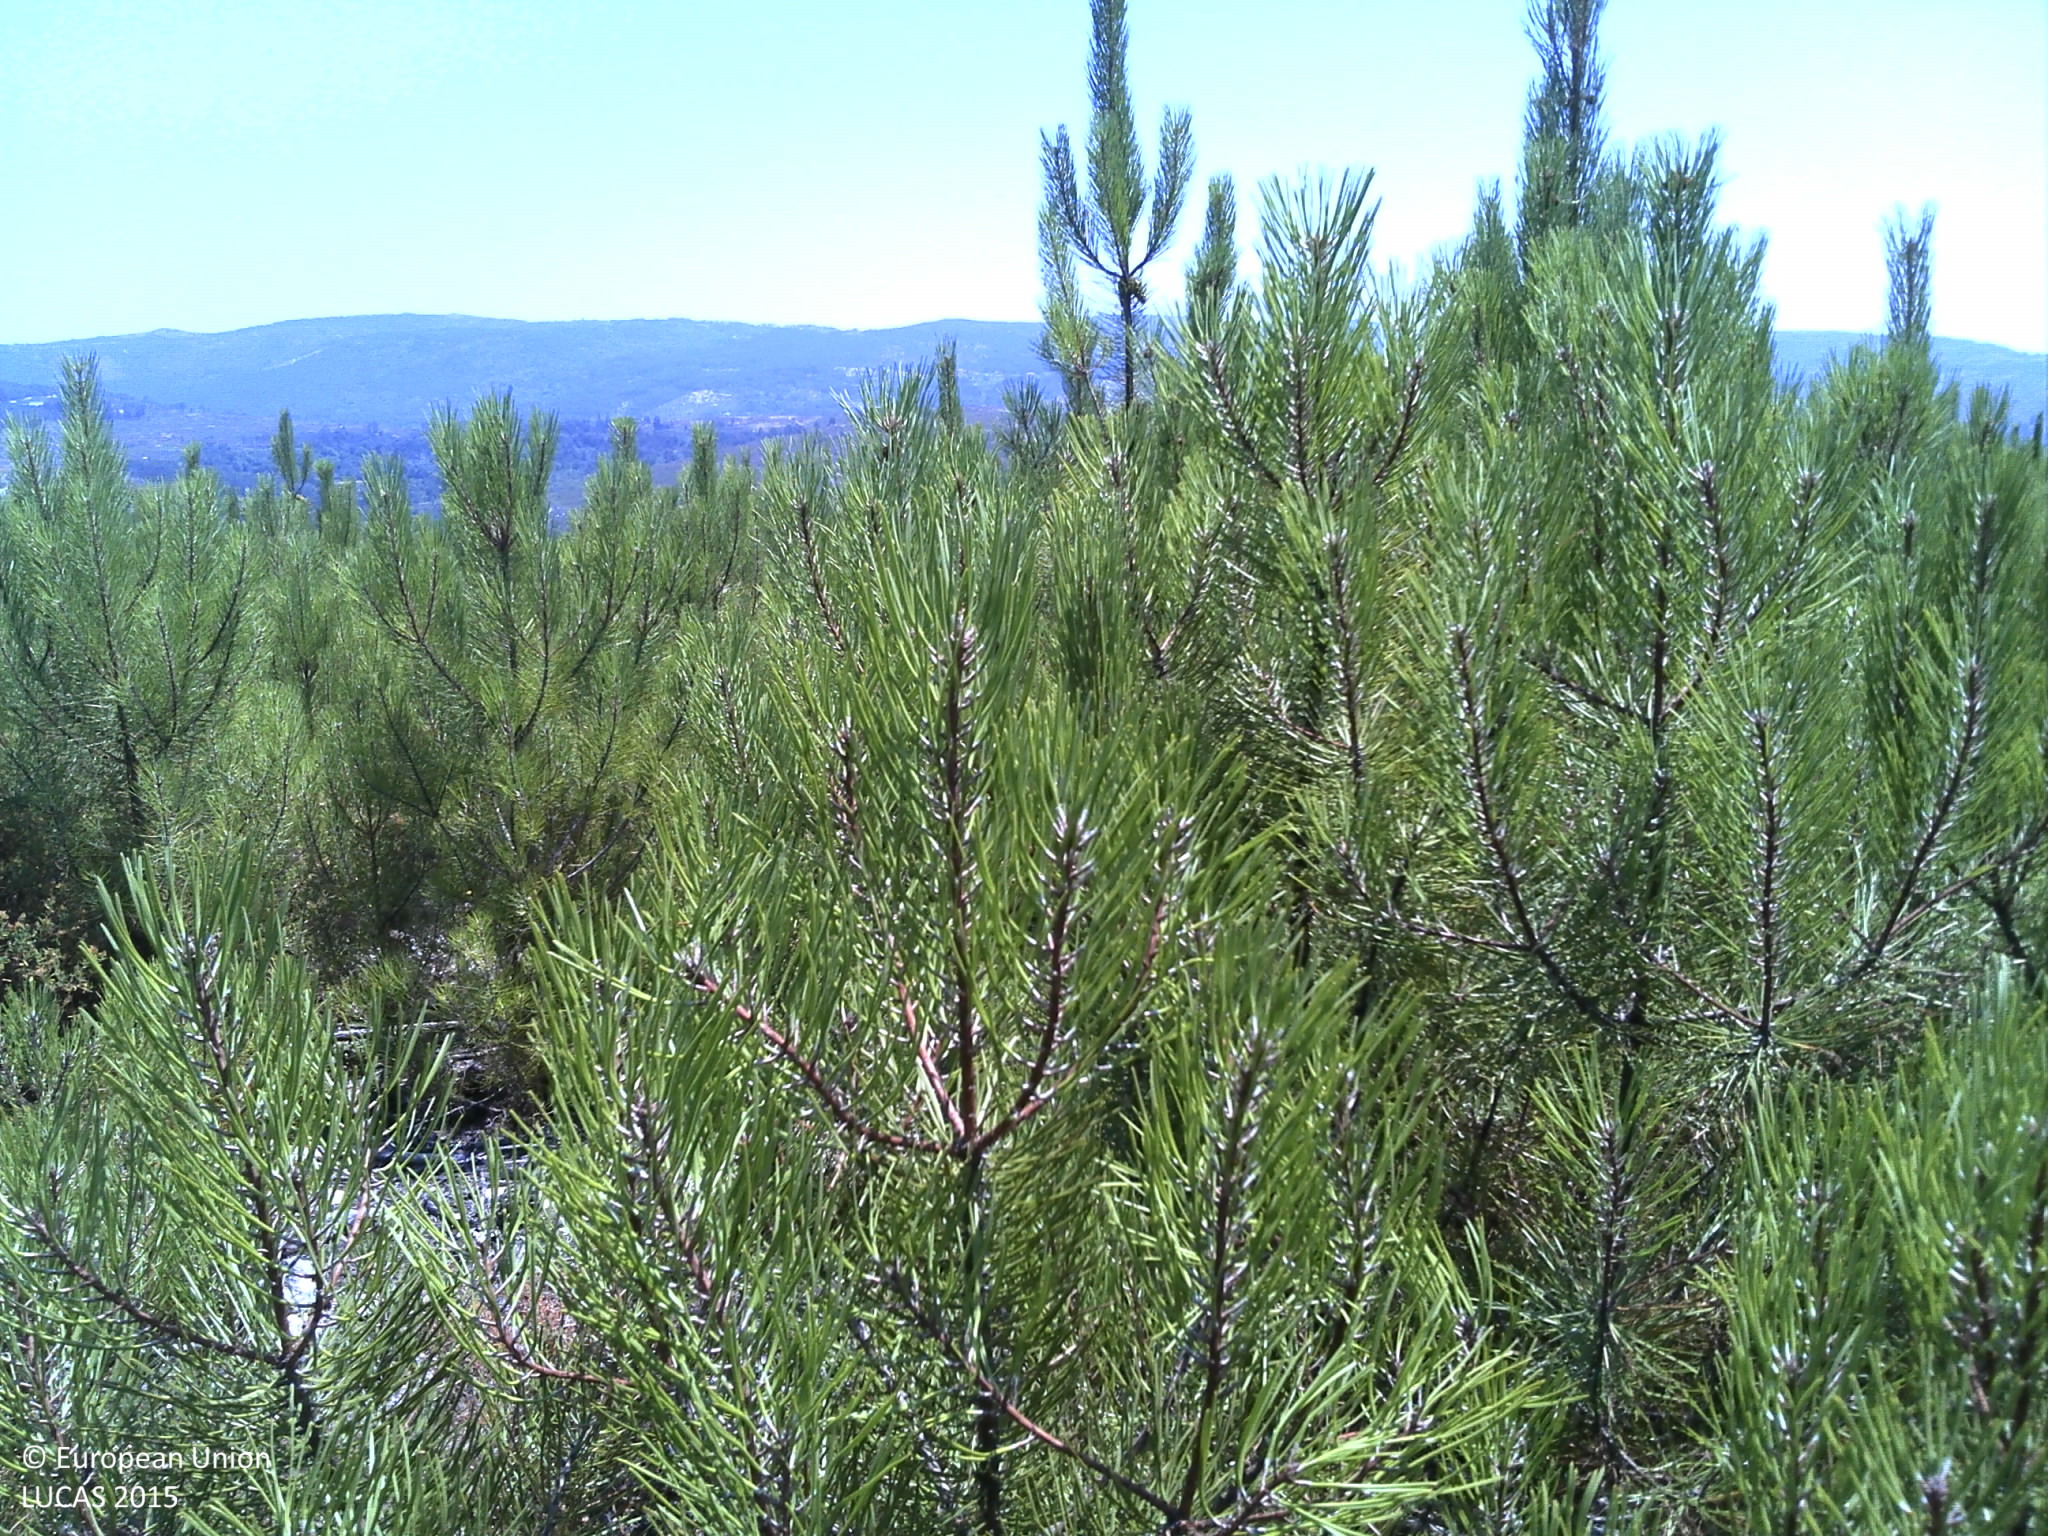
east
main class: Woodland
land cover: Pine dominated coniferous woodland
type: coniferous forest of the mediterranean region
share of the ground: 25 - 50 %
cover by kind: shrubs 60 %, coniferous forest trees 30 %, unconsolidated bare surface 10 %
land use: Forestry
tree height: < 5 m
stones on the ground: 10 - 25 %
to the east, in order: Pine dominated coniferous woodland; Shrubland without tree cover; Rock outcrops; Shrubland with sparse tree cover; Tracks; Shrubland without tree cover
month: July
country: PT
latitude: 40.8182
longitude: -7.9232
